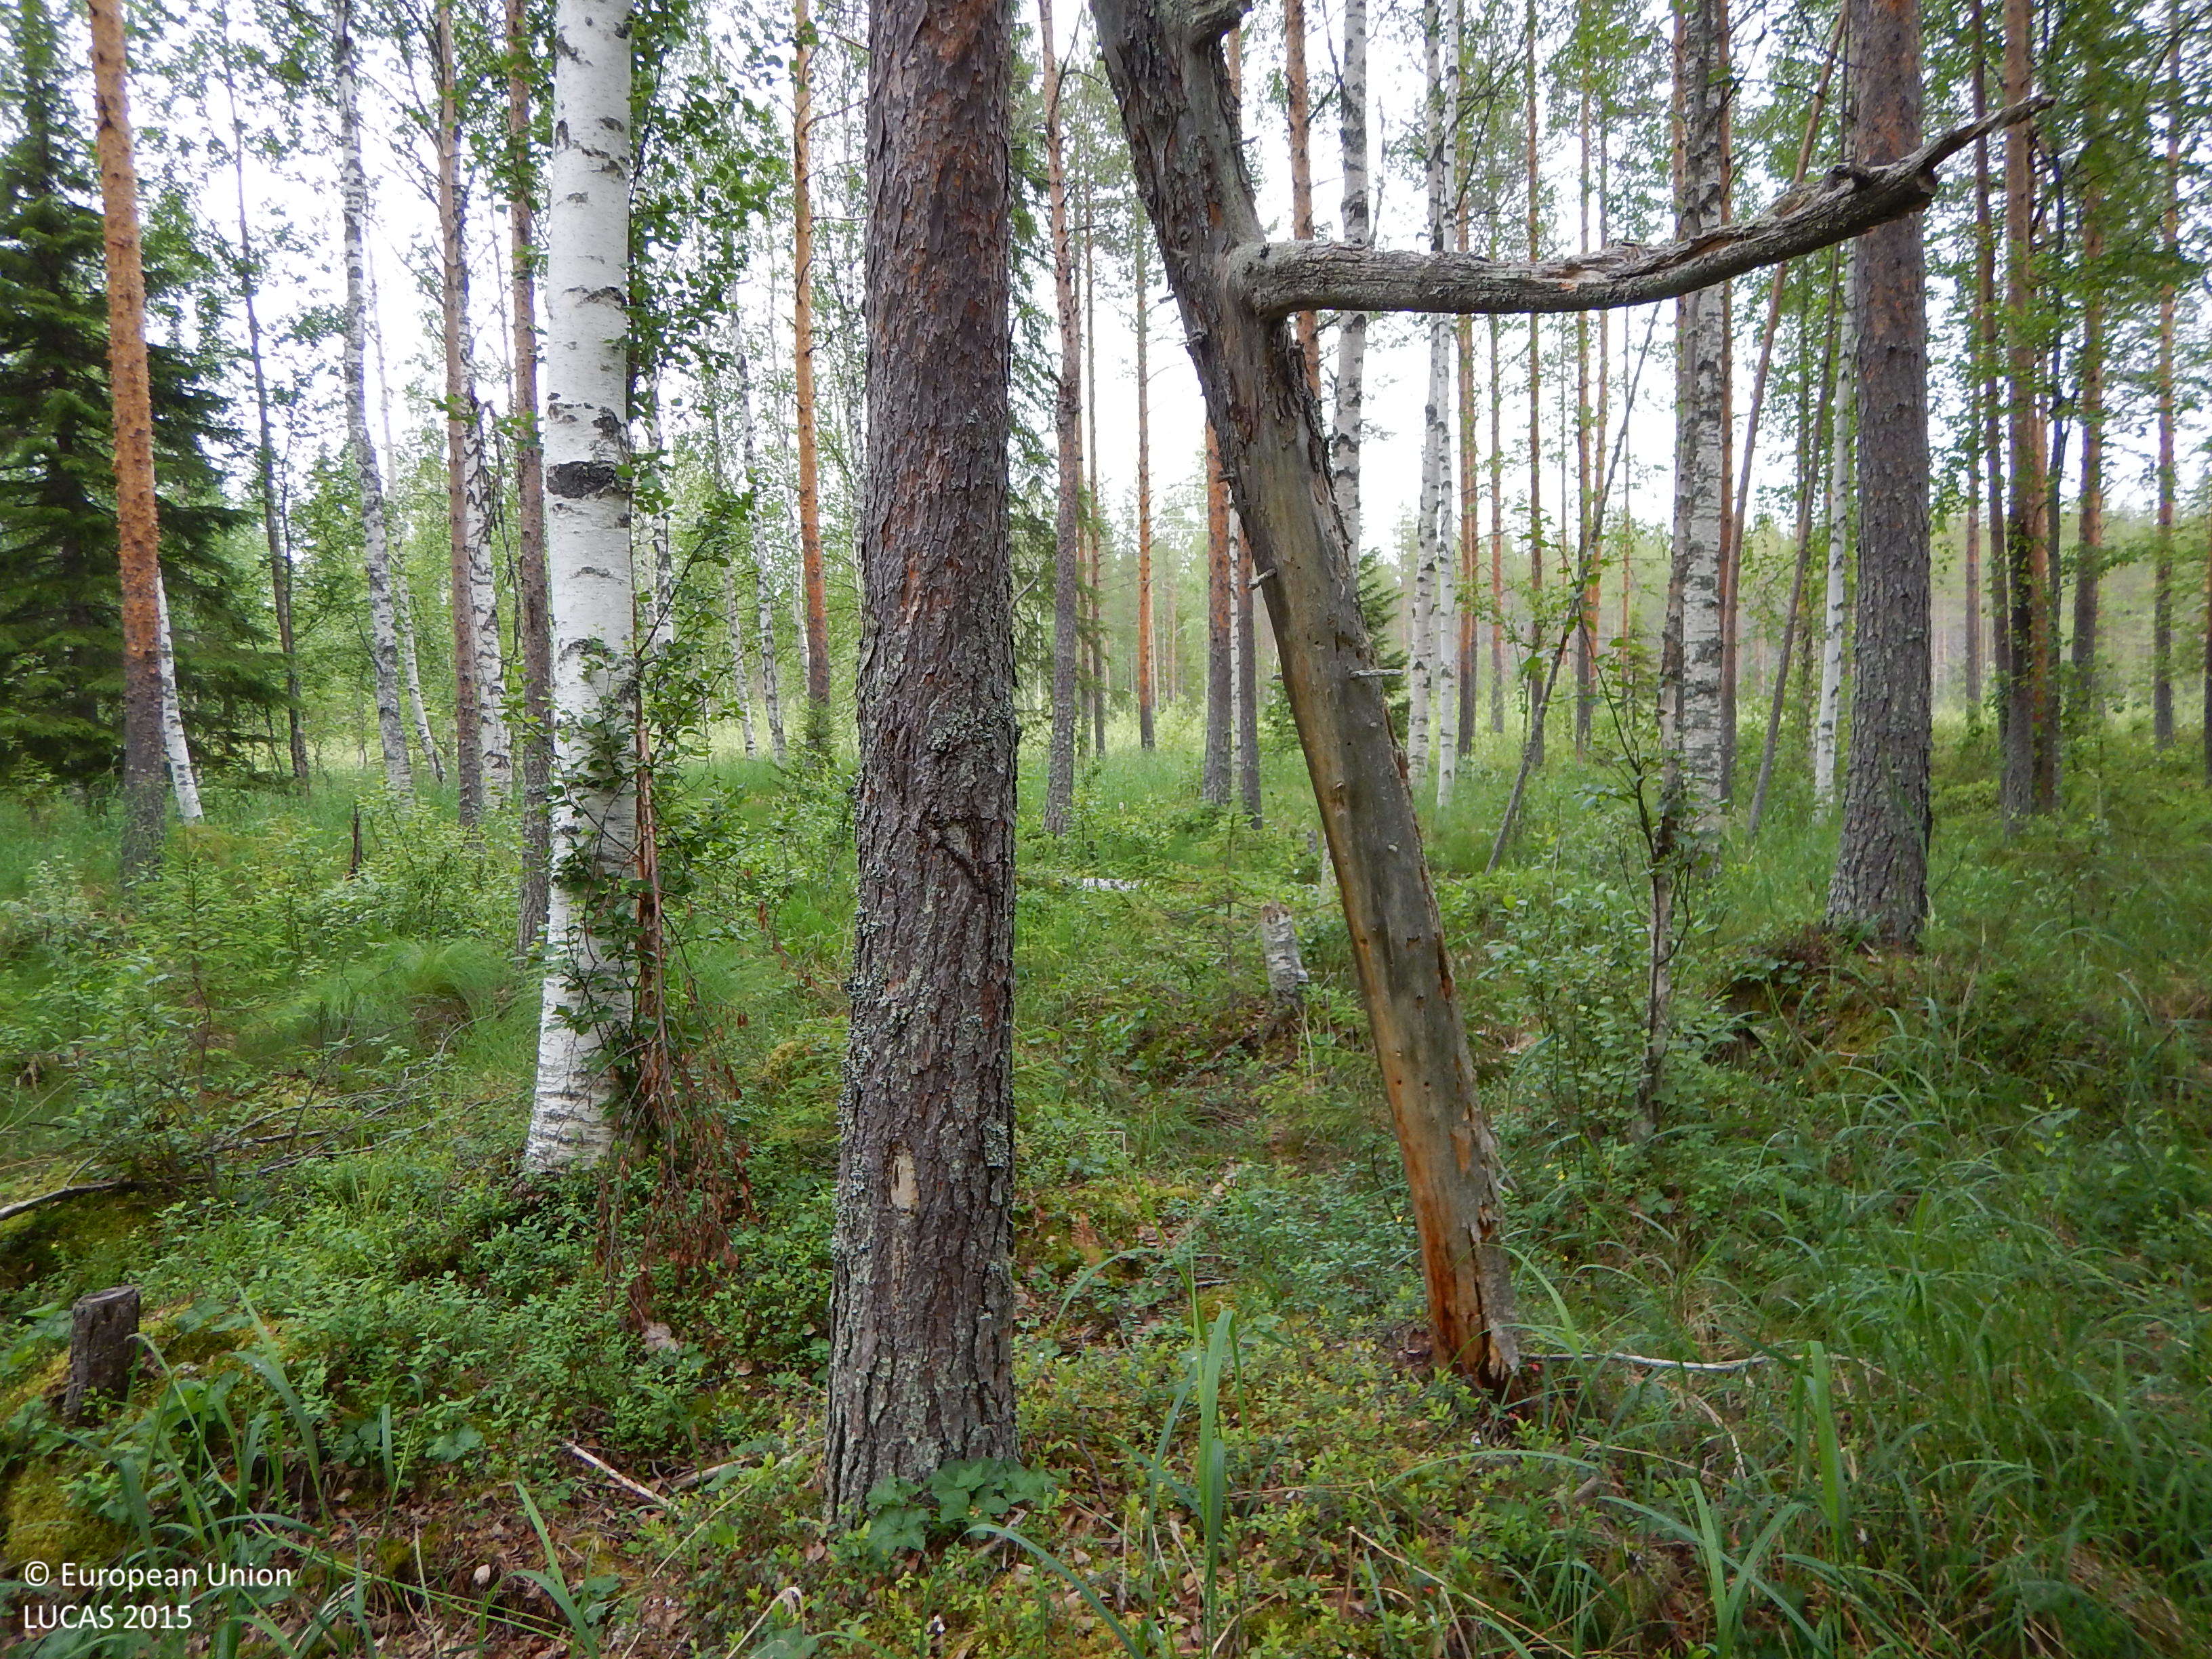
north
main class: Woodland
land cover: Other mixed woodland
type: boreal forest
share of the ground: 50 - 75 %
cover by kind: broadleaved forest trees 30 %, coniferous forest trees 20 %, herbaceous plants 20 %, lichens and mosses 20 %, shrubs 10 %
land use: Forestry
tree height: > 5 m
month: July
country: SE
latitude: 64.9607
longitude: 19.9431
